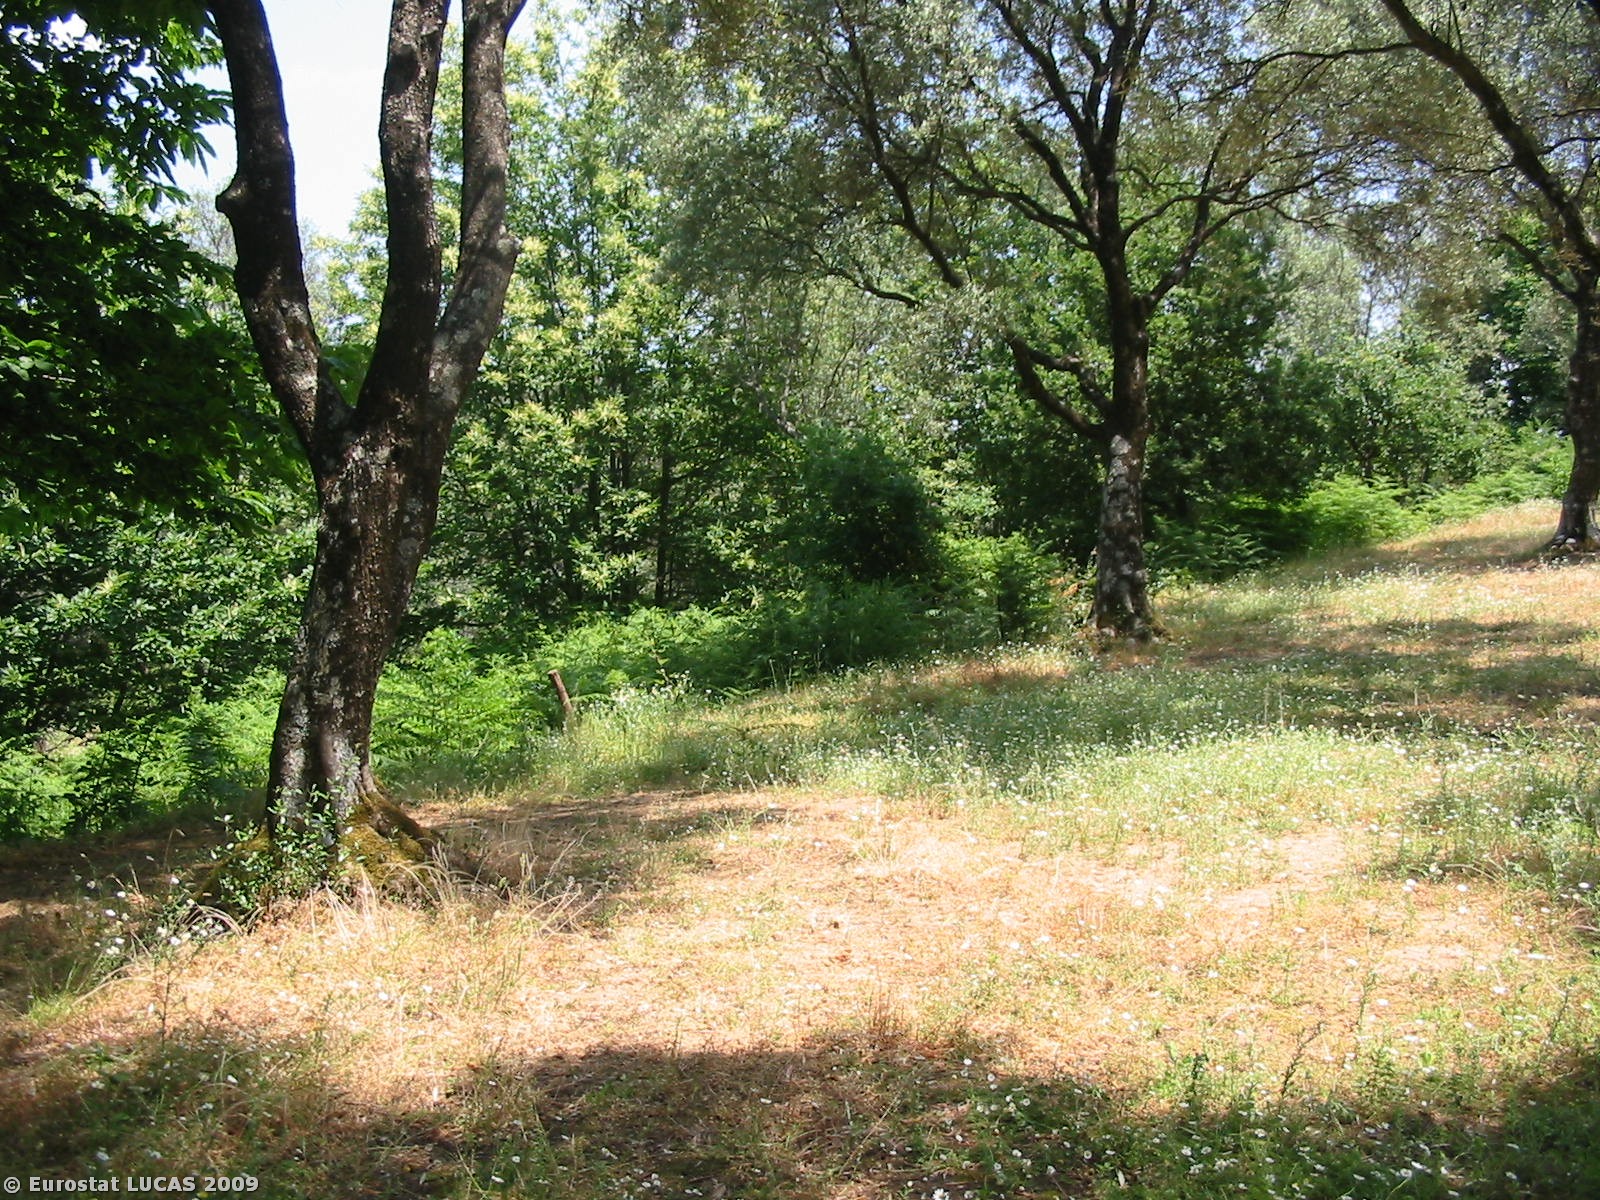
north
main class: Cropland
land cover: Olive groves
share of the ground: 50 - 75 %
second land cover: Spontaneously vegetated surfaces
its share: > 75 %
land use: Agriculture (excluding fallow land and kitchen gardens)
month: June
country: IT
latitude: 38.2542
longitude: 15.9178
